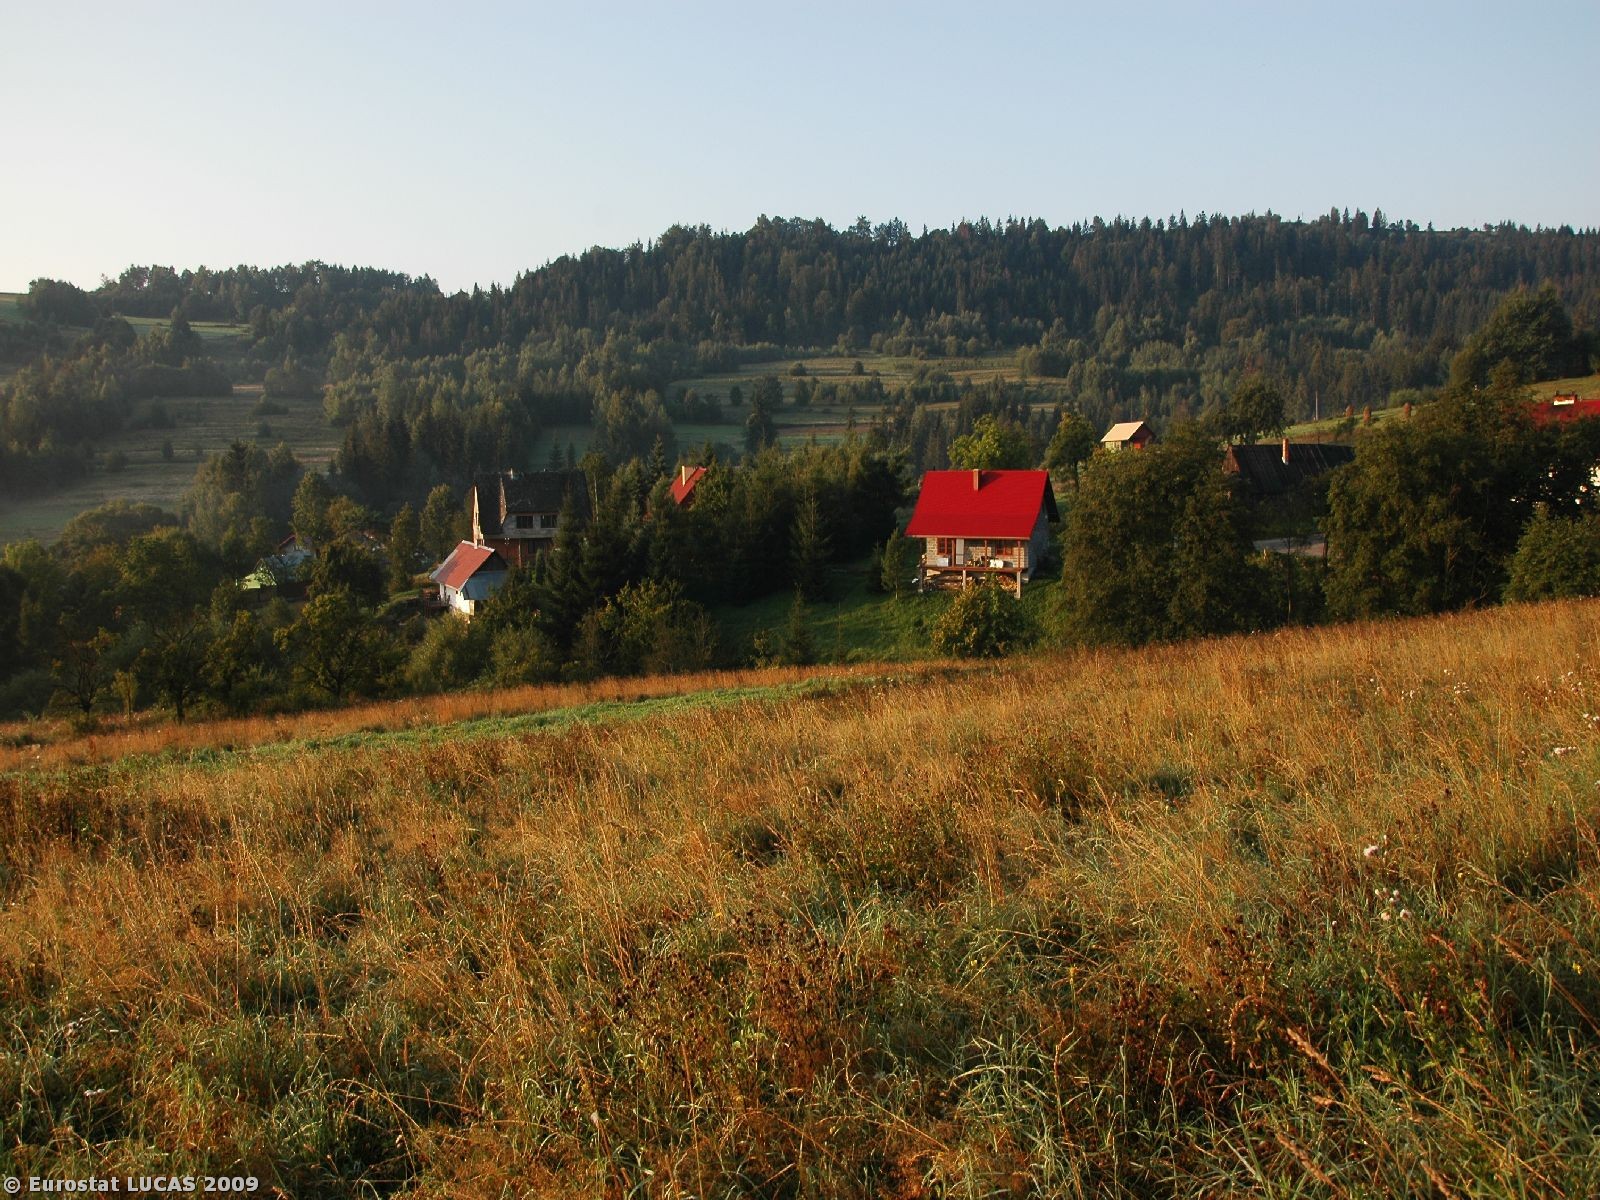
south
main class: Grassland
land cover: Grassland without tree/shrub cover
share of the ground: > 75 %
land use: Unused
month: August
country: PL
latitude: 49.5567
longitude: 18.9941
